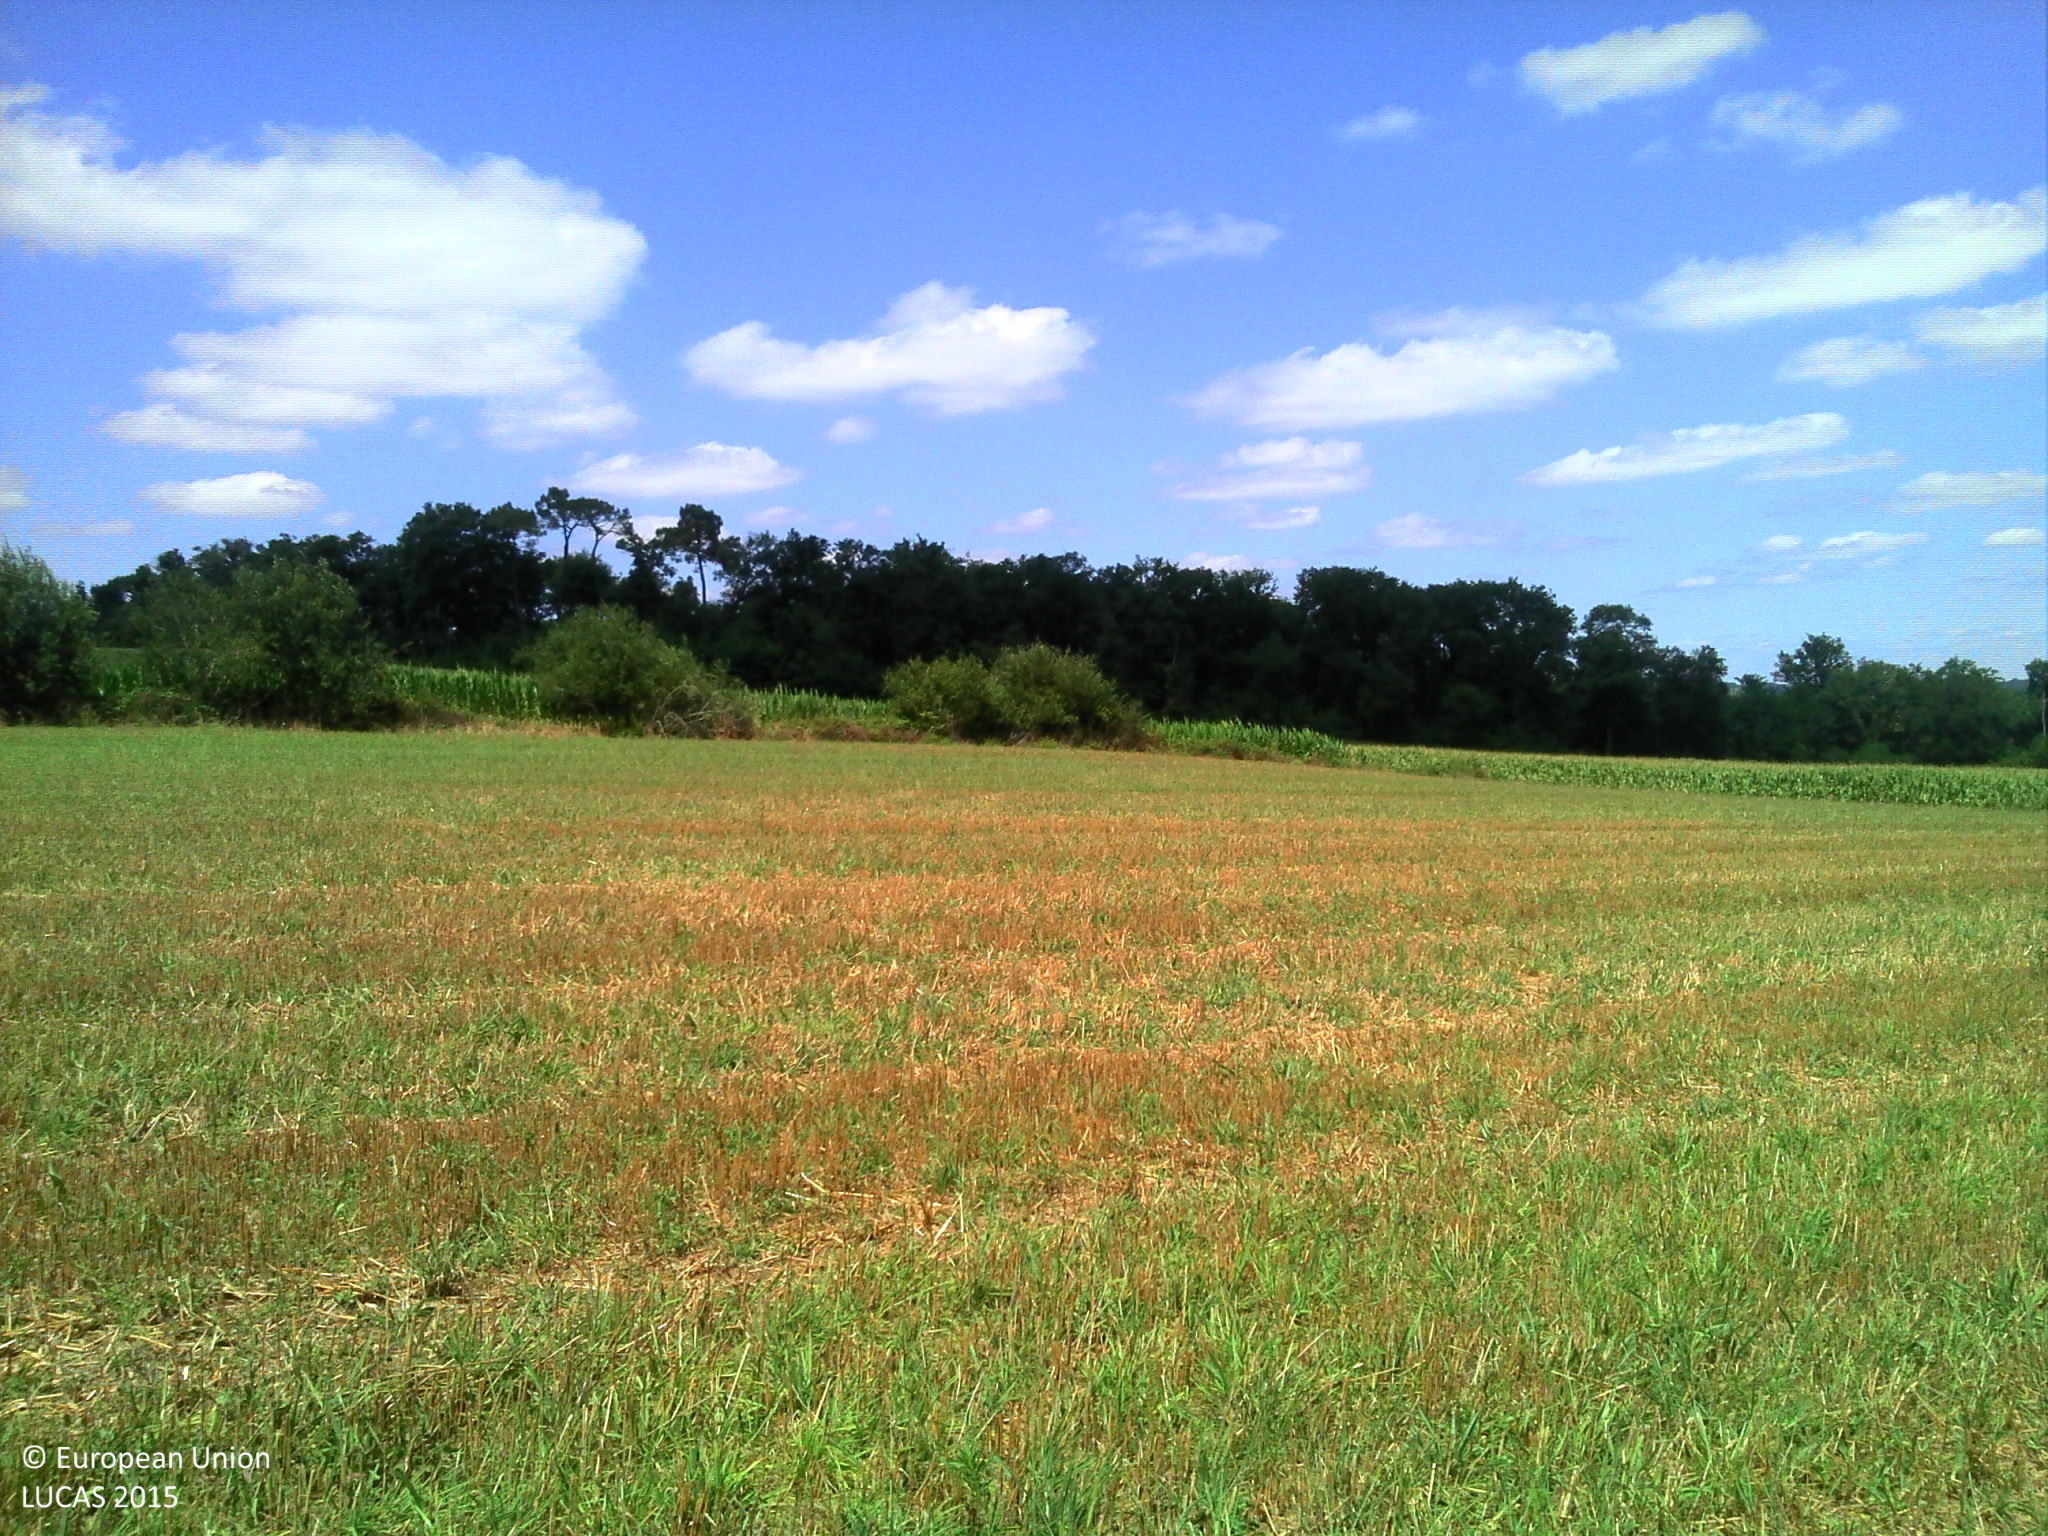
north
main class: Cropland
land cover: Temporary grasslands
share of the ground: > 75 %
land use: Agriculture (excluding fallow land and kitchen gardens)
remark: Harvested field
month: July
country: FR
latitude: 43.5181
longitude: -1.0868
